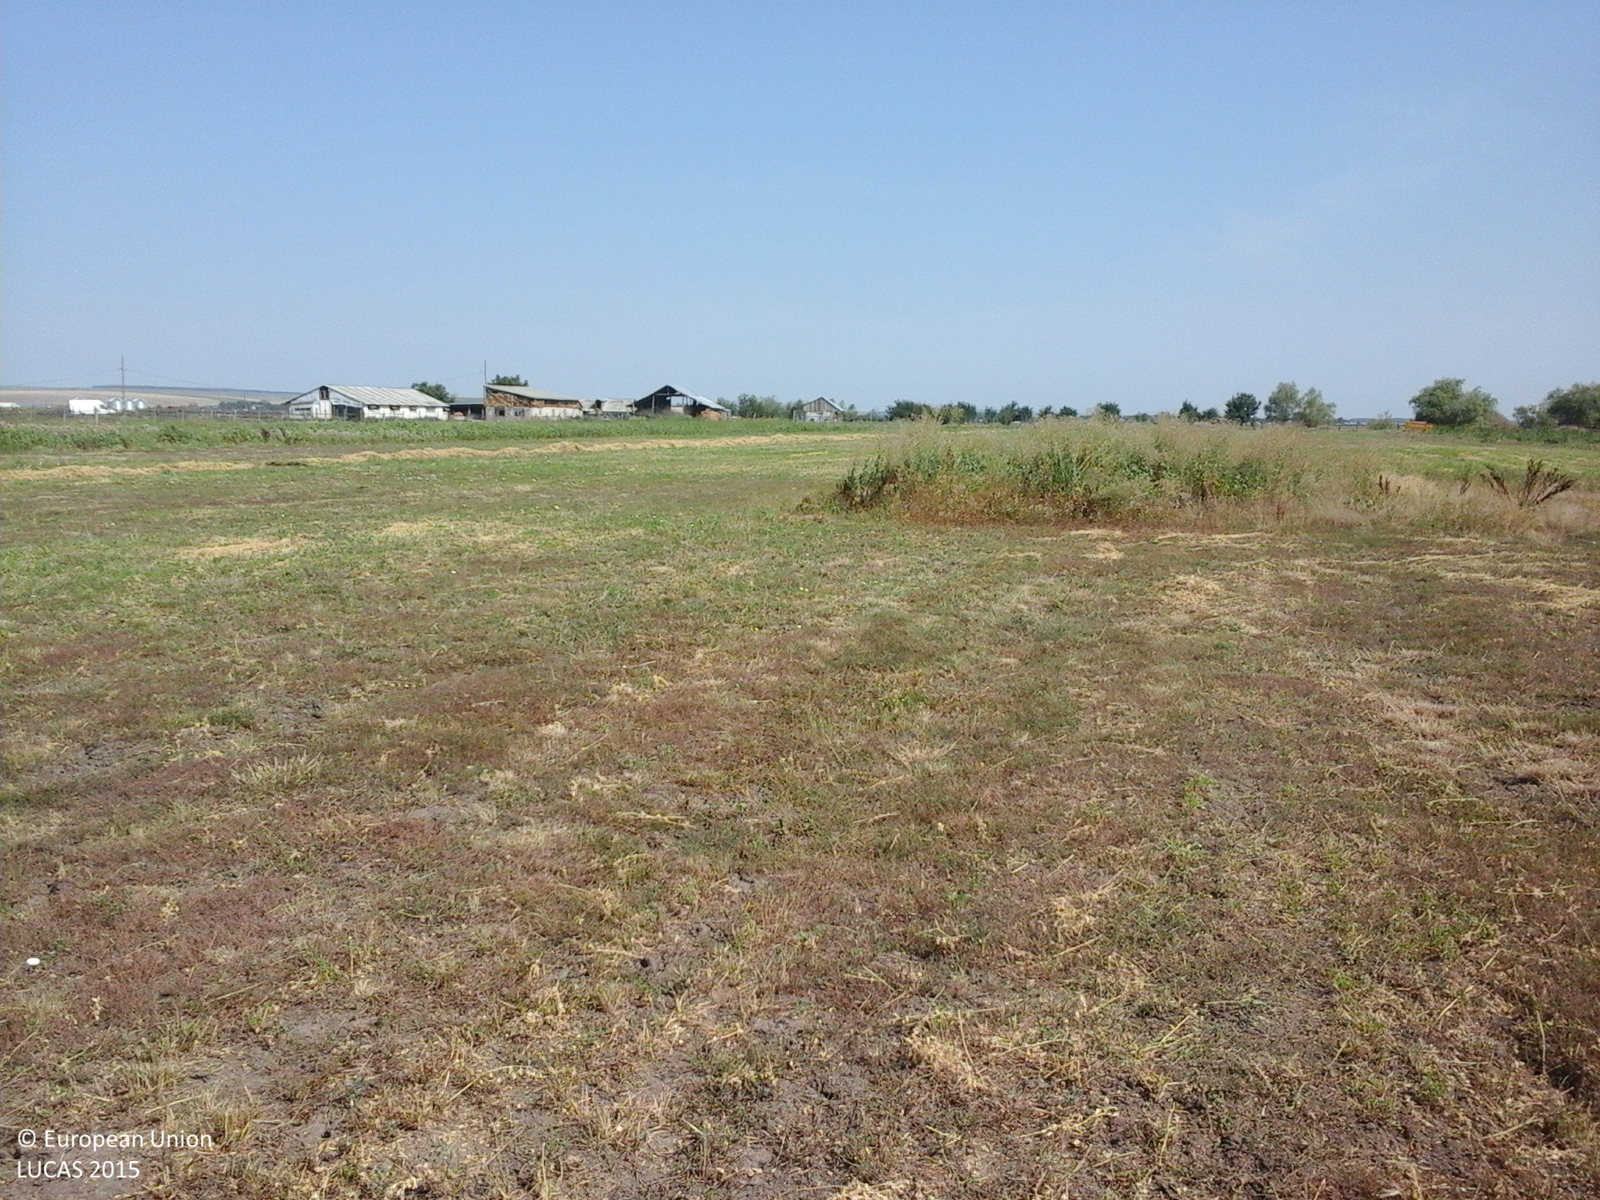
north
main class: Cropland
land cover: Lucerne
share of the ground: 25 - 50 %
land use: Agriculture (excluding fallow land and kitchen gardens)
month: July
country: RO
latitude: 45.8809
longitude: 27.4338
